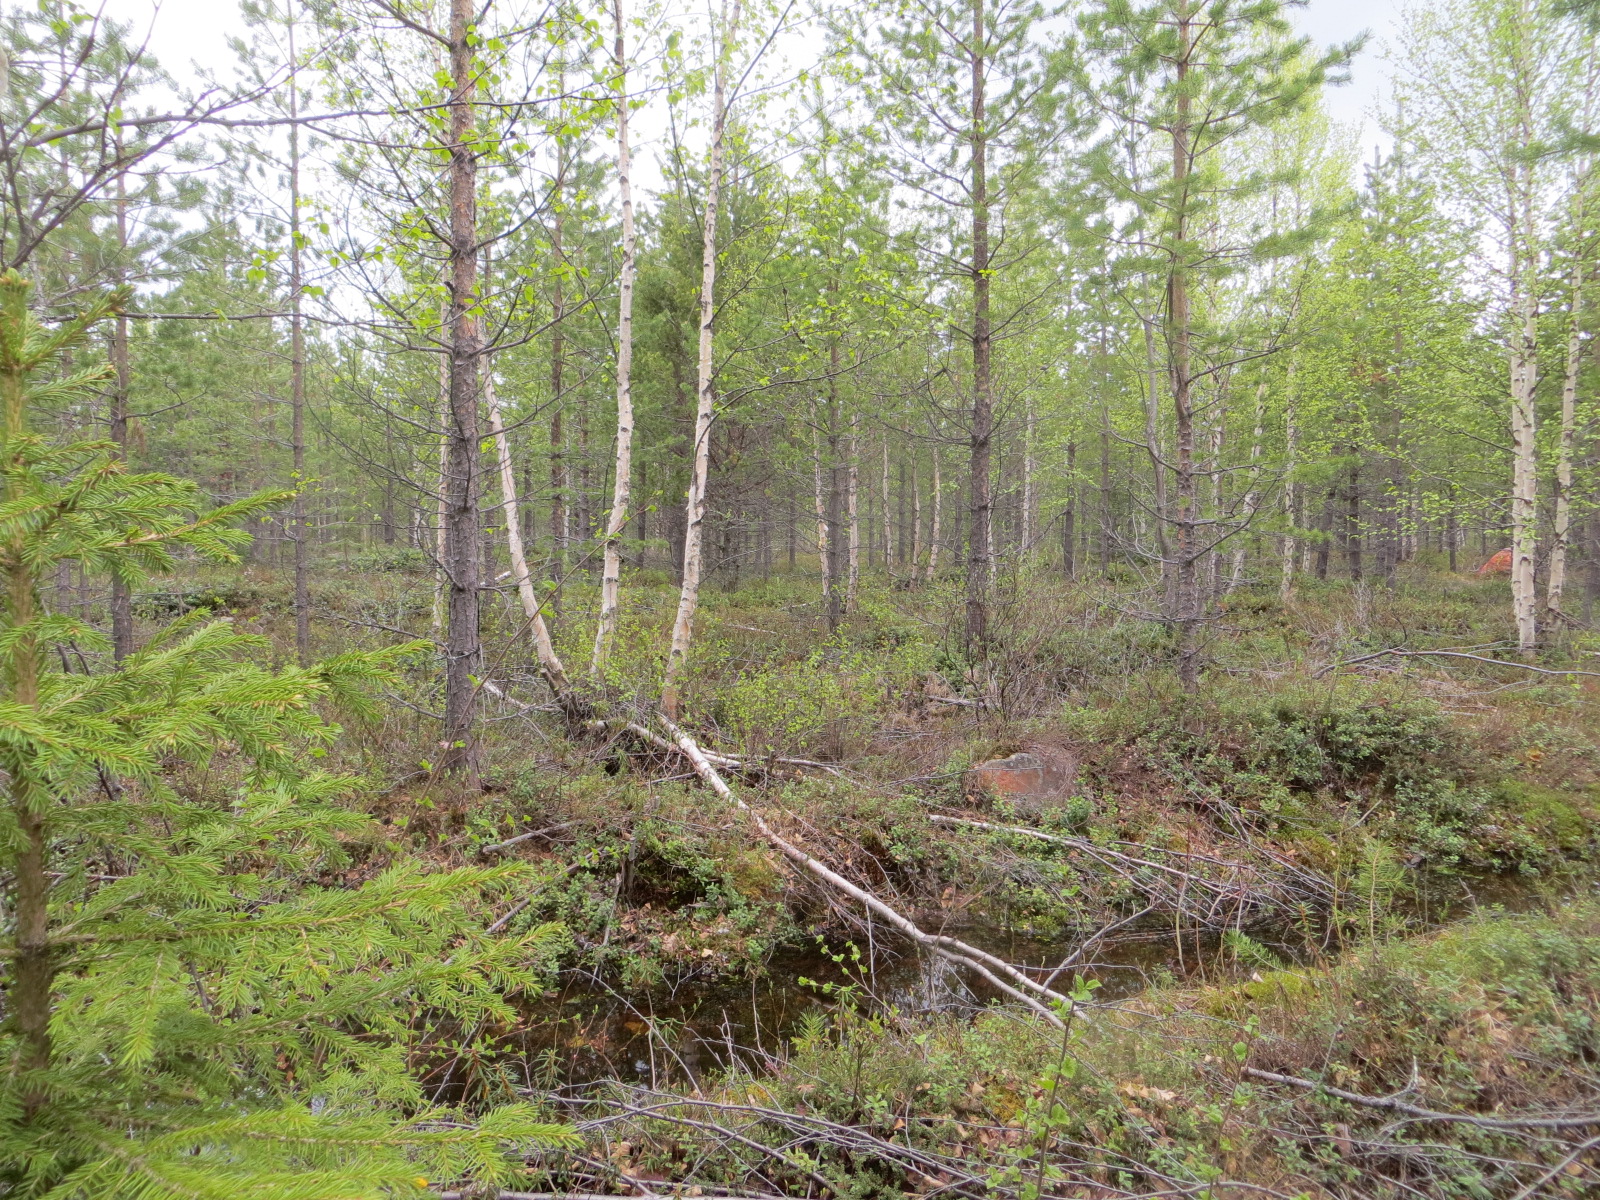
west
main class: Woodland
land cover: Pine dominated mixed woodland
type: boreal forest
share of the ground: > 75 %
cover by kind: coniferous forest trees 50 %, broadleaved forest trees 25 %, shrubs 25 %
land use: Forestry
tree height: > 5 m
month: June
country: FI
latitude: 67.4839
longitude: 24.8495
